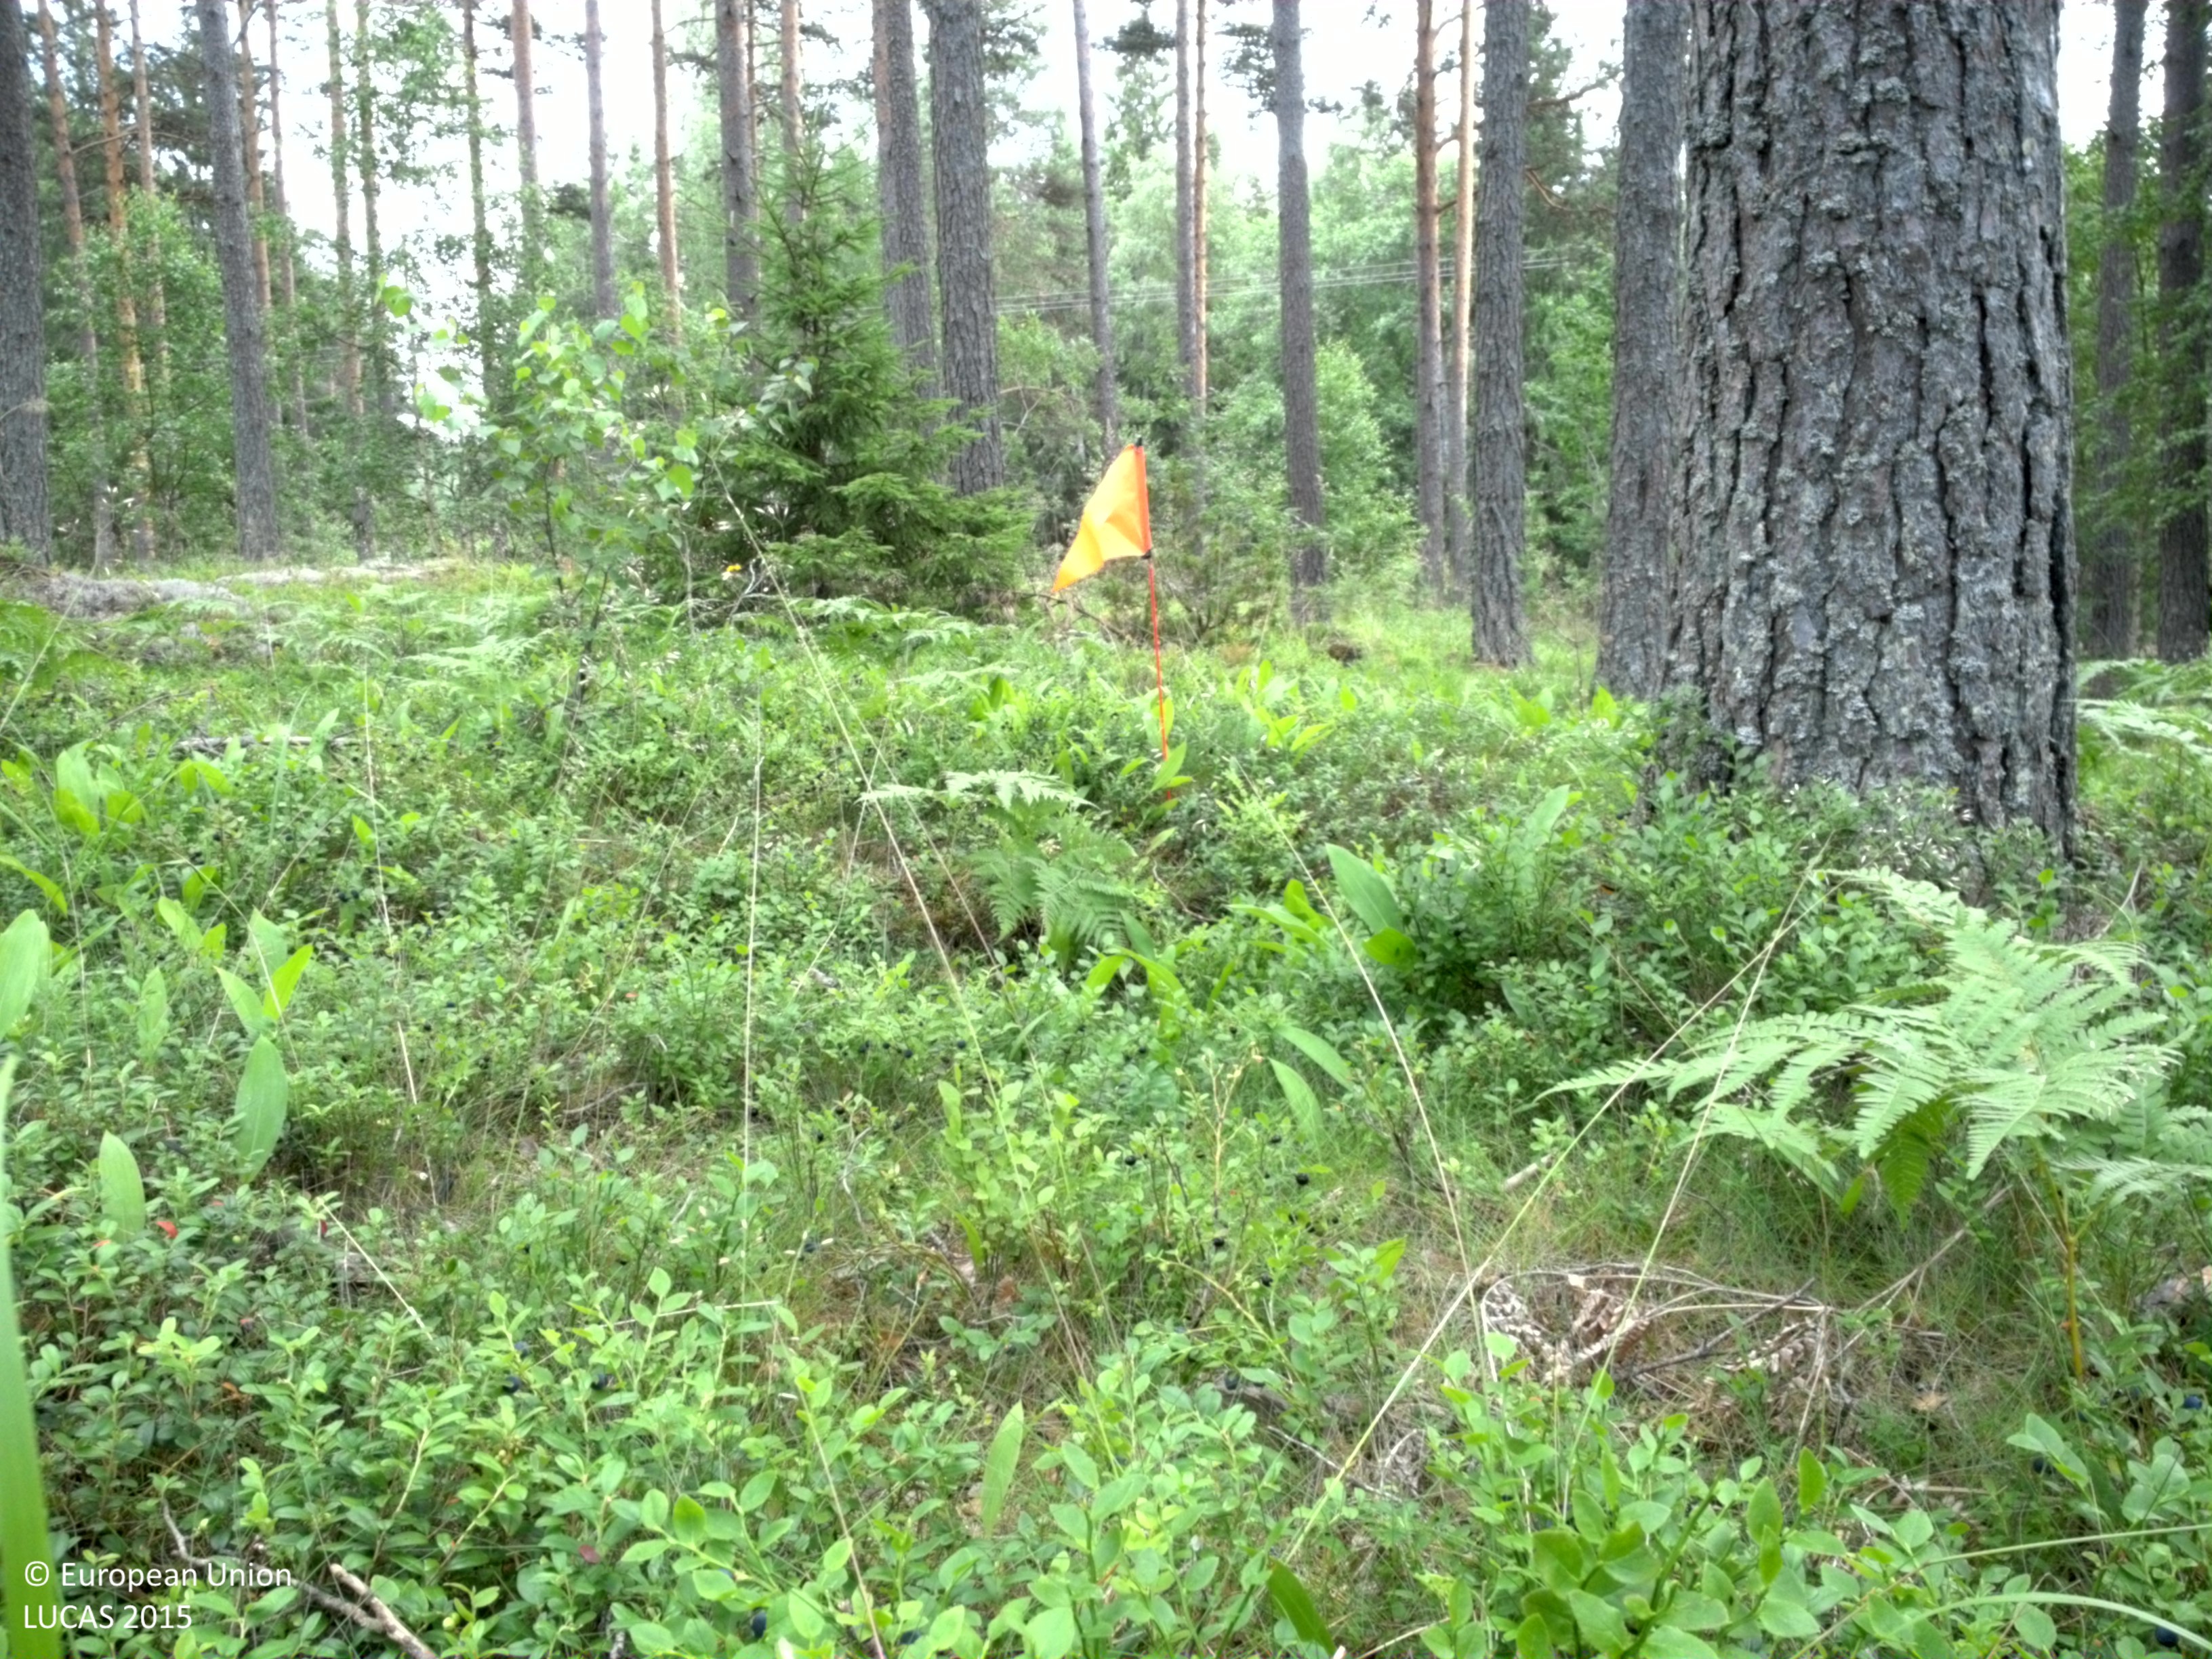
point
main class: Woodland
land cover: Pine dominated coniferous woodland
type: boreal forest
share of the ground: > 75 %
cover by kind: coniferous forest trees 70 %, herbaceous plants 20 %, broadleaved forest trees 10 %
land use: Forestry
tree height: > 5 m
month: July
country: SE
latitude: 59.5894
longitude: 18.3408
